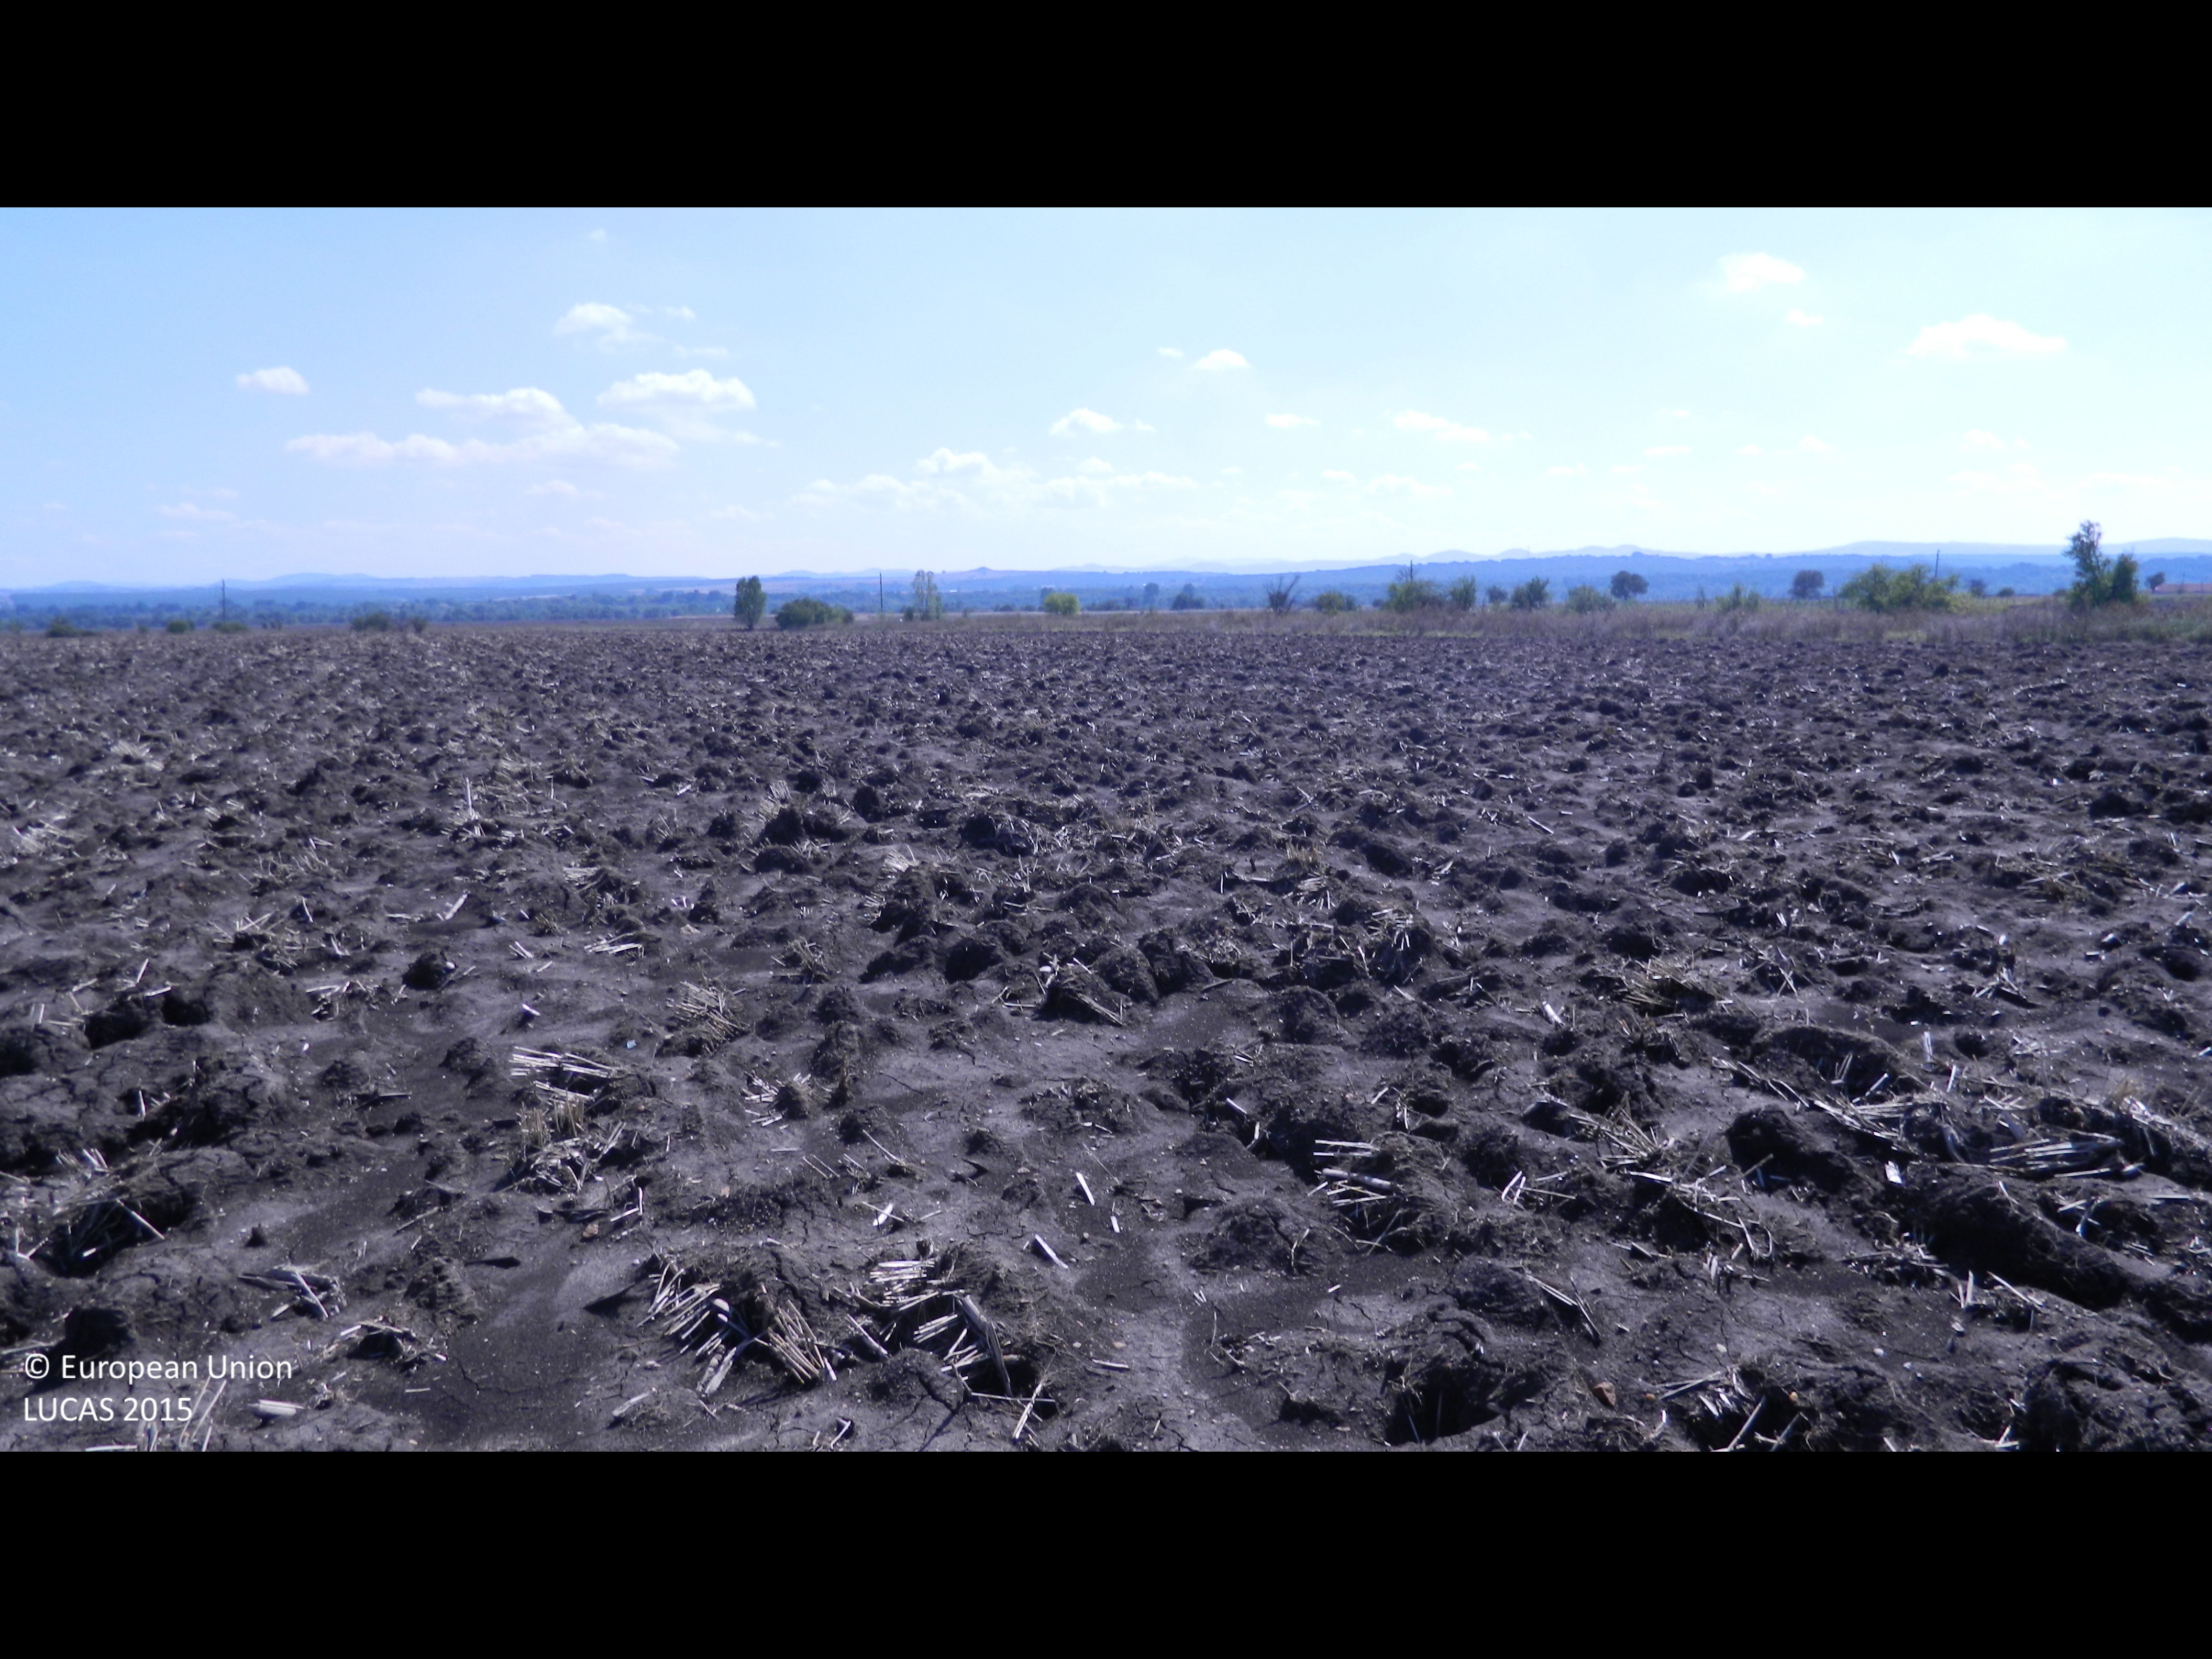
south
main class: Cropland
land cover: Barley
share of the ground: < 10 %
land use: Agriculture (excluding fallow land and kitchen gardens)
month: September
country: BG
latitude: 41.8602
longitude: 25.5920
